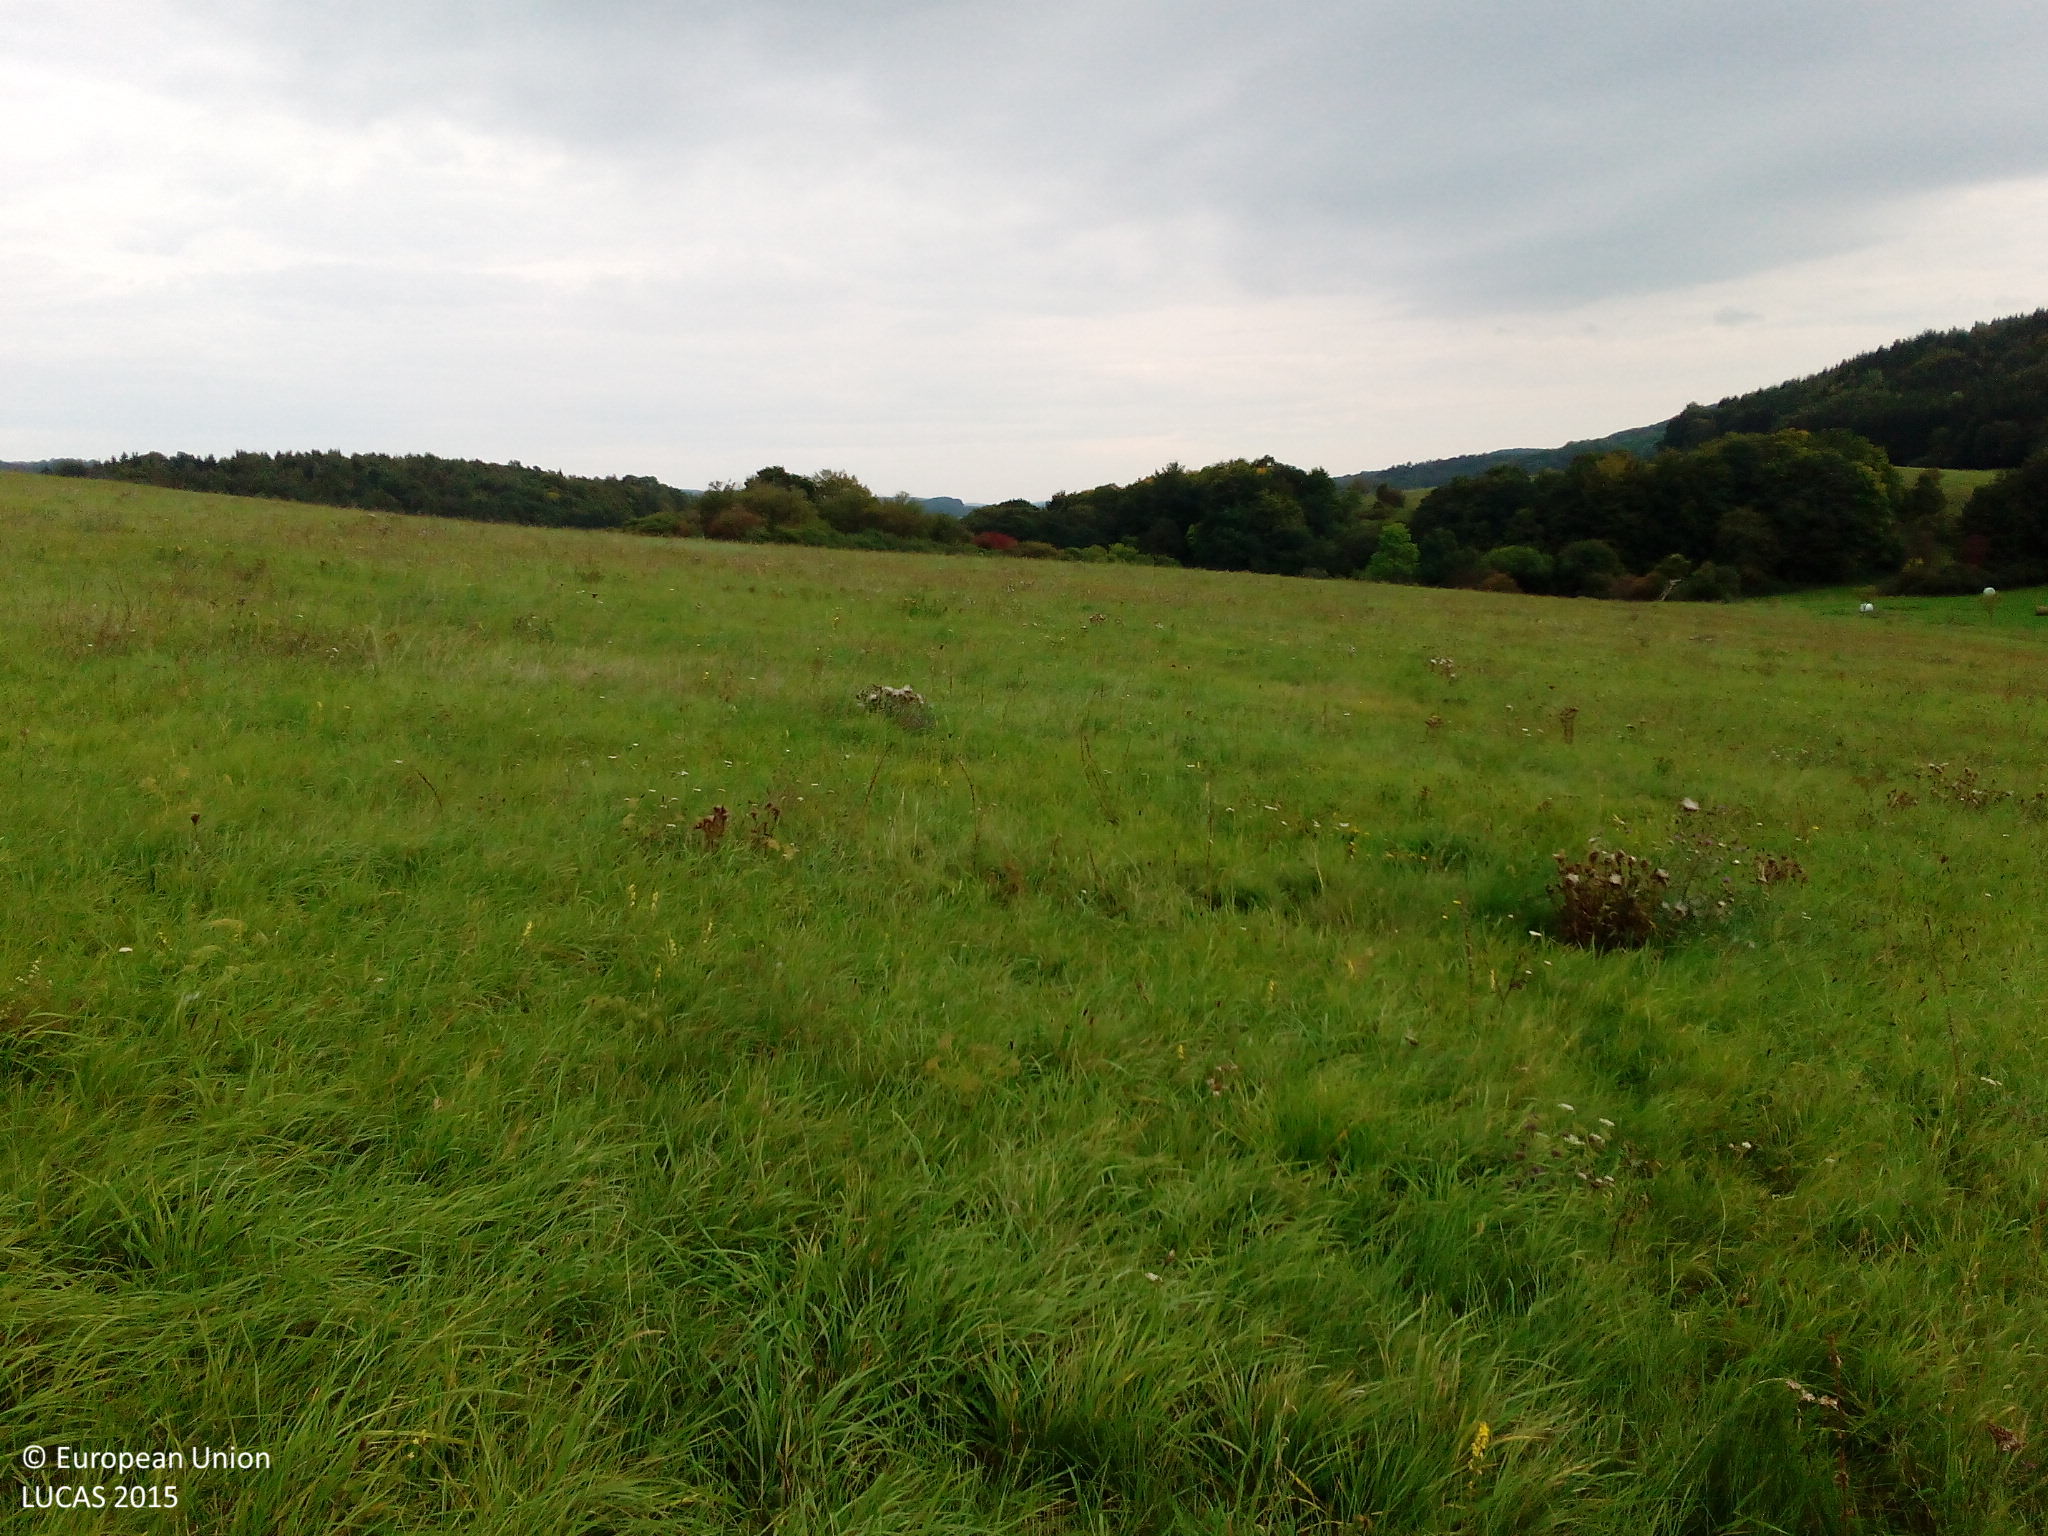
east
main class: Grassland
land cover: Grassland without tree/shrub cover
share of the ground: > 75 %
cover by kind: herbaceous plants 100 %
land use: Agriculture (excluding fallow land and kitchen gardens)
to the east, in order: Grassland without tree/shrub cover
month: September
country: DE
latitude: 51.4922
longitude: 11.0223
